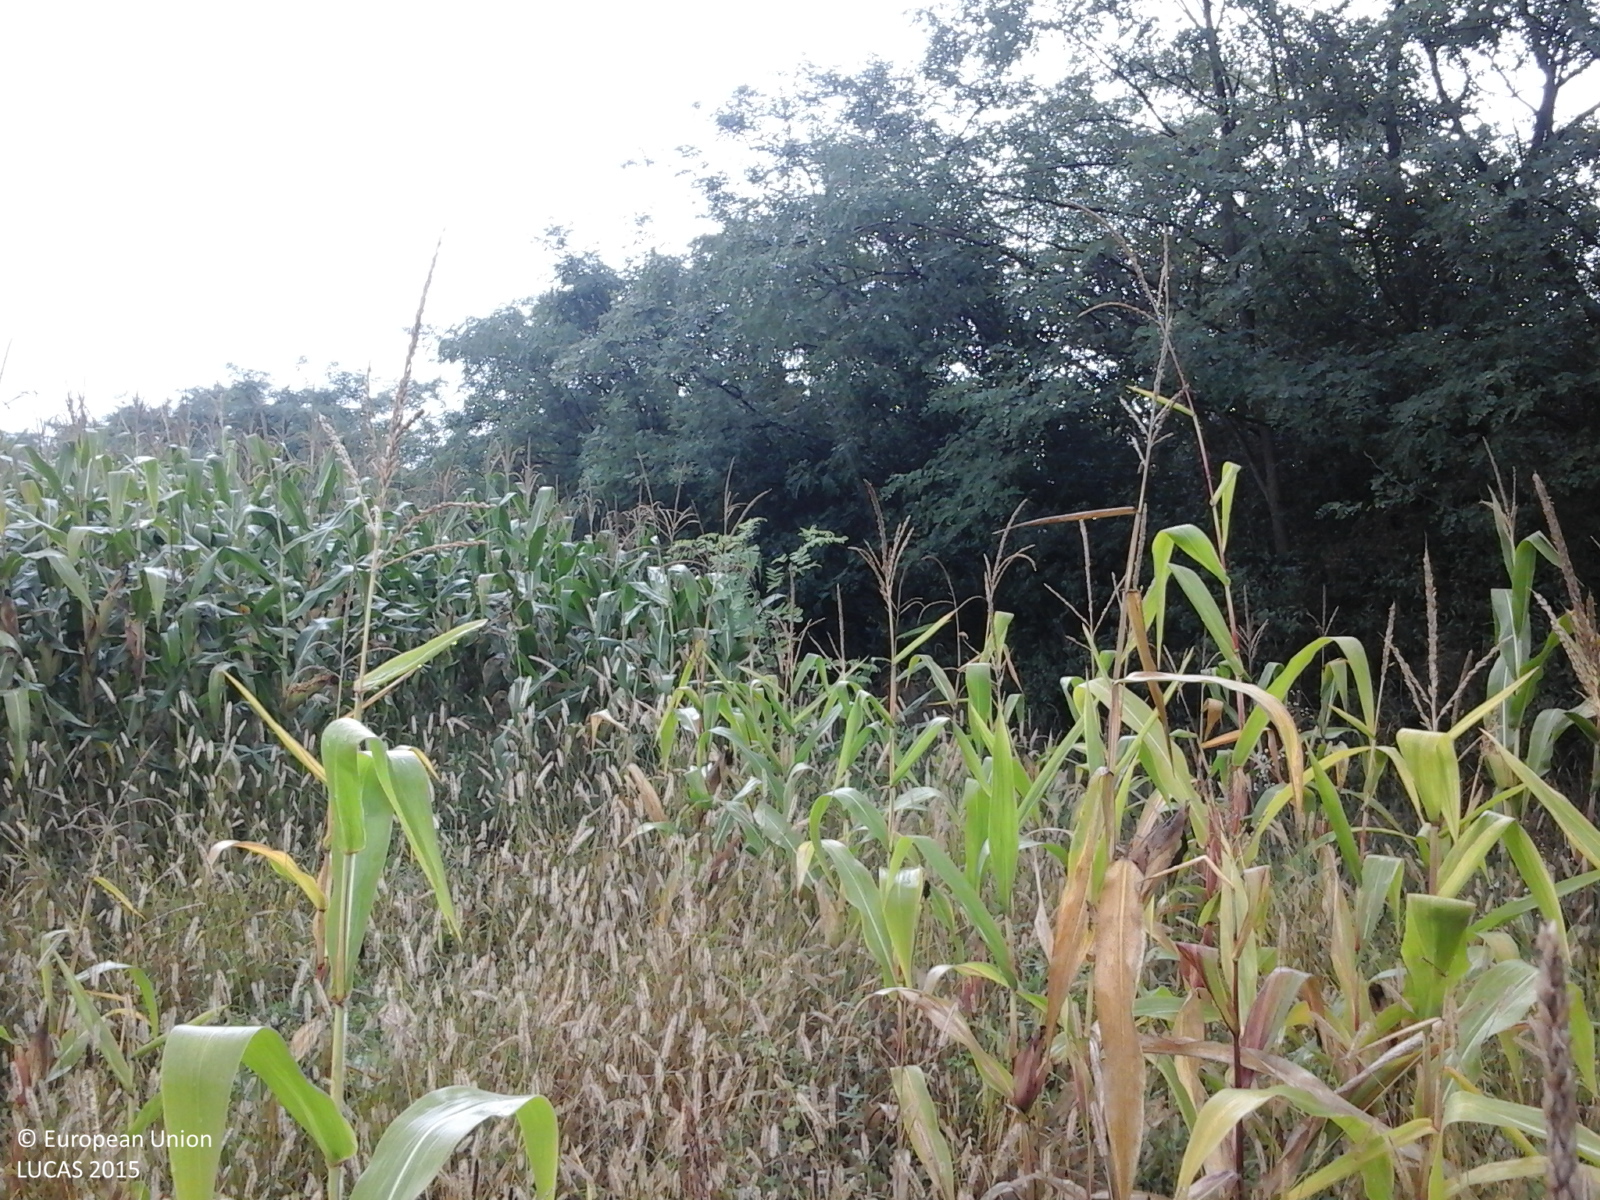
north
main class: Cropland
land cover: Maize
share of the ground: > 75 %
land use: Agriculture (excluding fallow land and kitchen gardens)
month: September
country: RO
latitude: 46.9950
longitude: 22.5340
